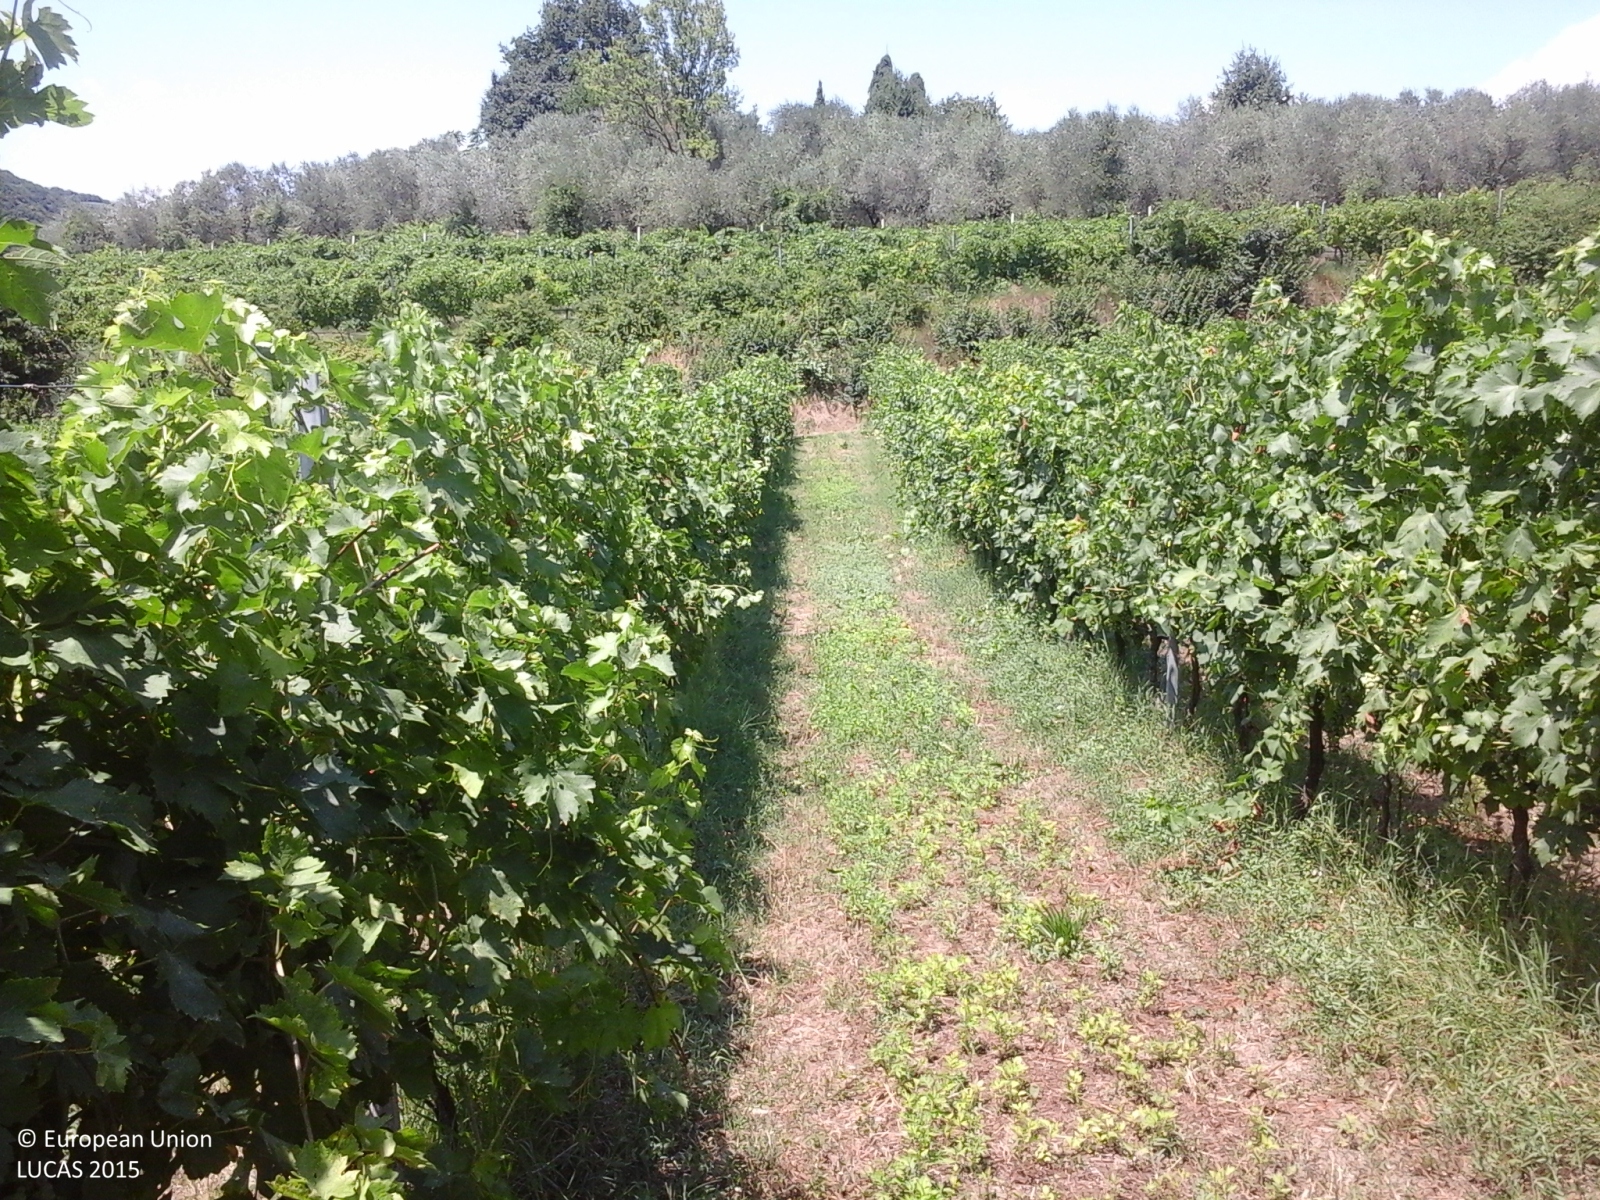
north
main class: Cropland
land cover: Vineyards
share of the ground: 25 - 50 %
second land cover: Grassland without tree/shrub cover
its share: > 75 %
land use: Agriculture (excluding fallow land and kitchen gardens)
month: July
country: IT
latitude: 45.4625
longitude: 11.1108
